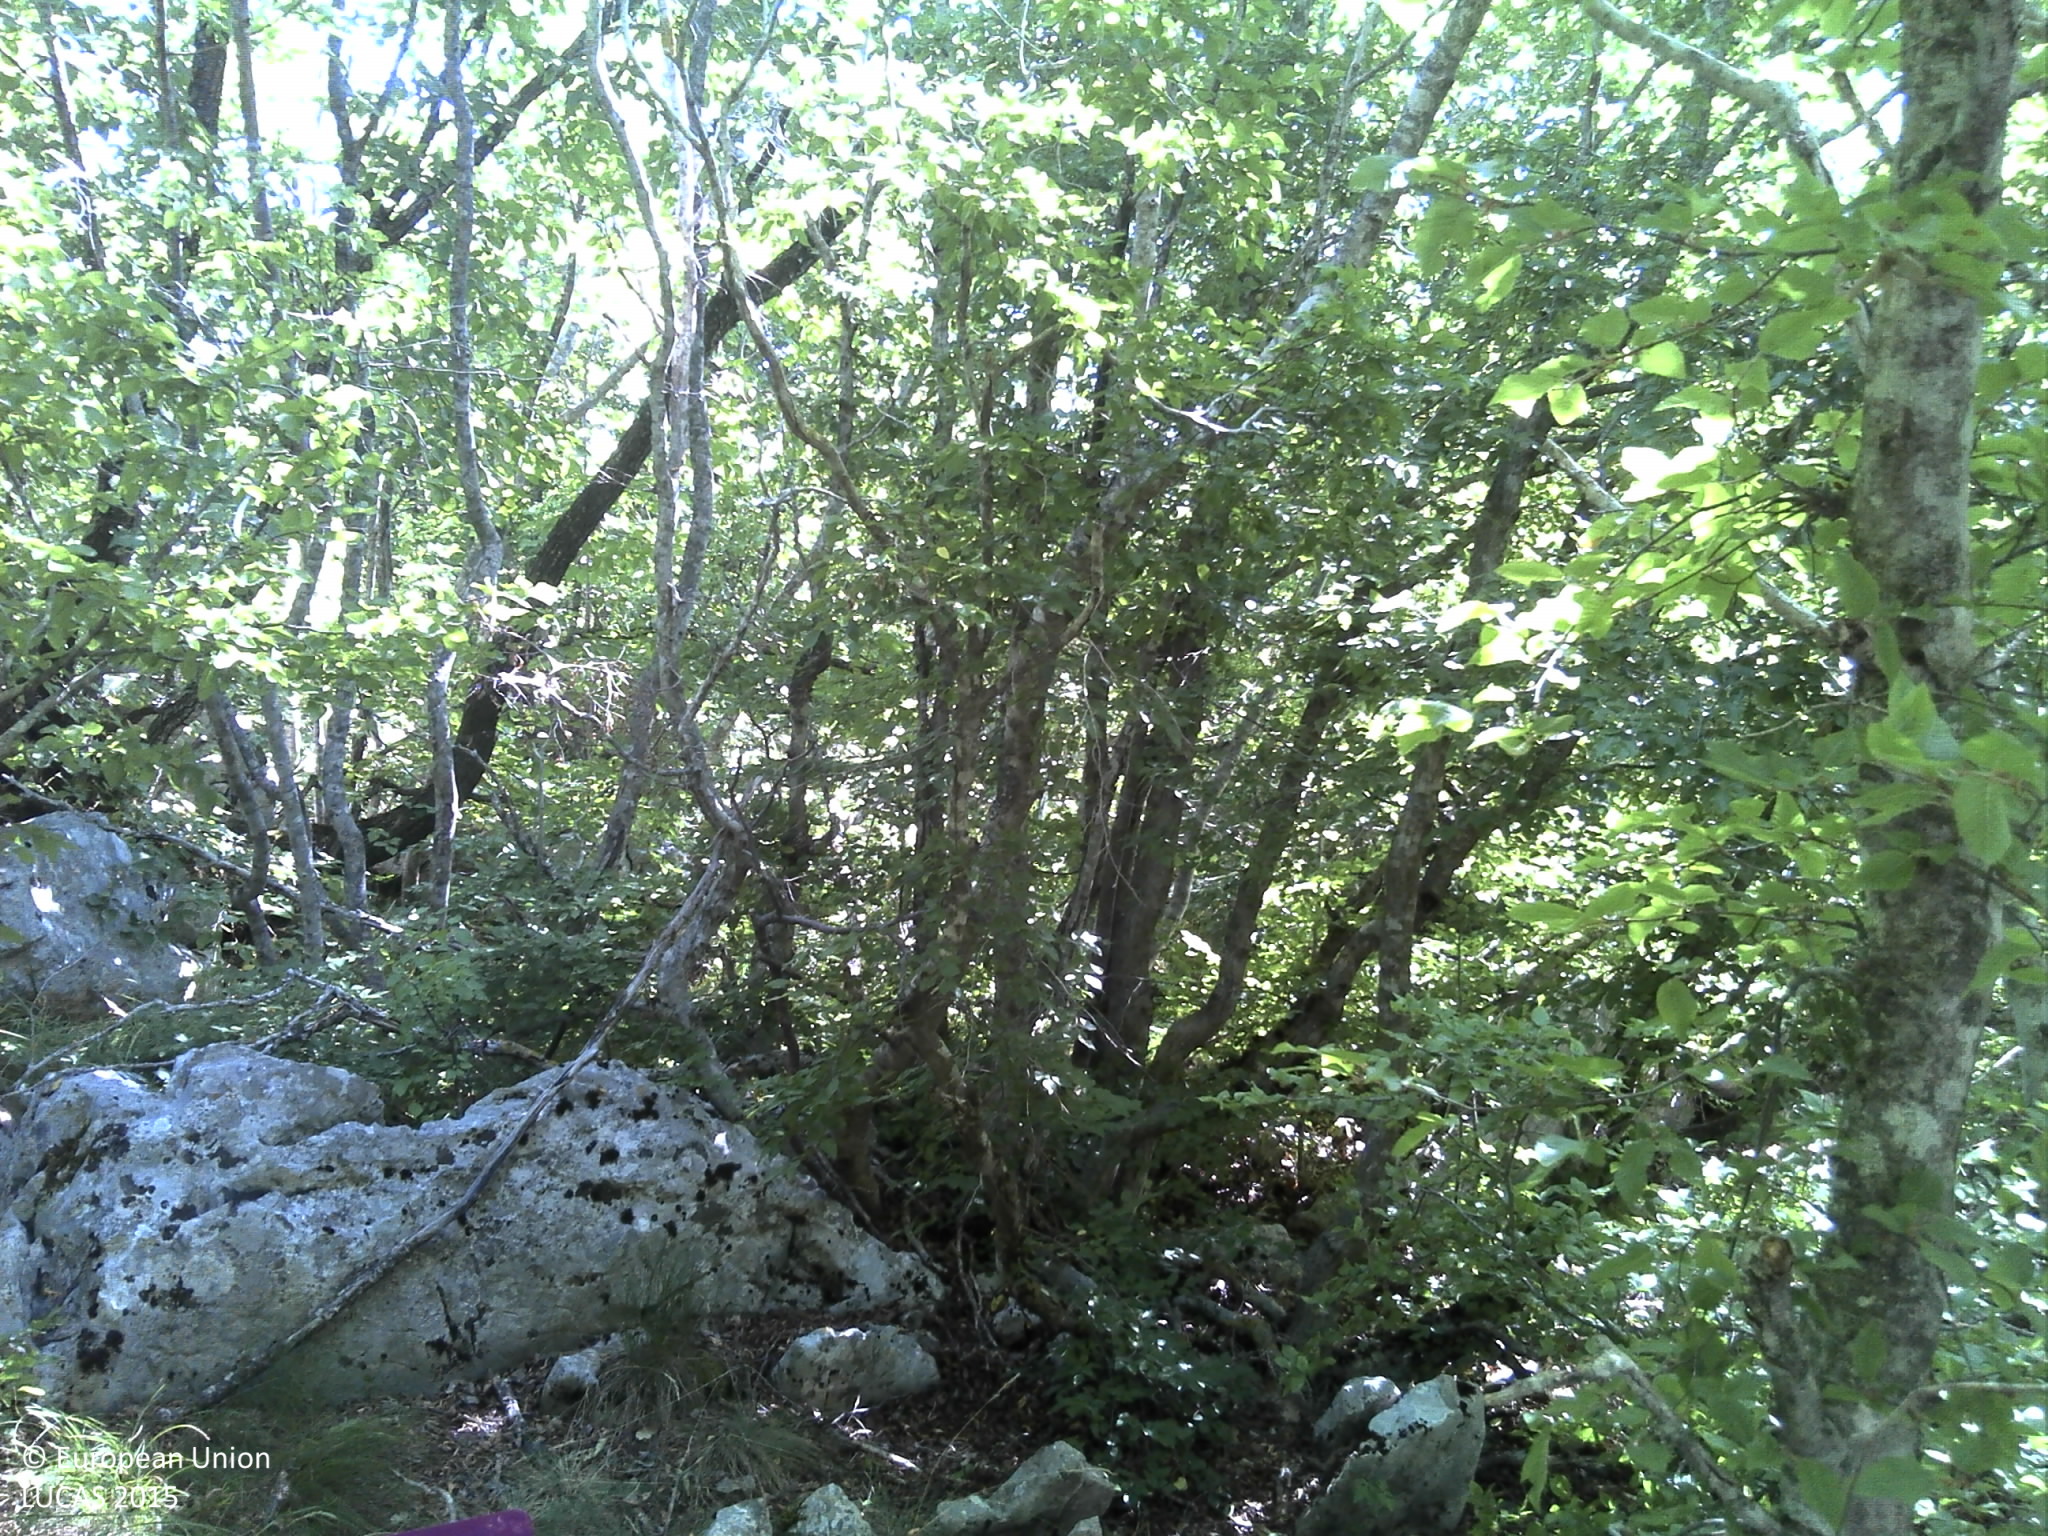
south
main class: Woodland
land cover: Broadleaved woodland
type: thermophilous deciduous forest
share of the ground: 25 - 50 %
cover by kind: broadleaved forest trees 50 %, shrubs 25 %, consolidated bare surface 15 %, herbaceous plants 5 %, lichens and mosses 5 %
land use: Semi-natural and natural areas not in use
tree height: > 5 m
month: July
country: HR
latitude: 43.5701
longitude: 17.0125
